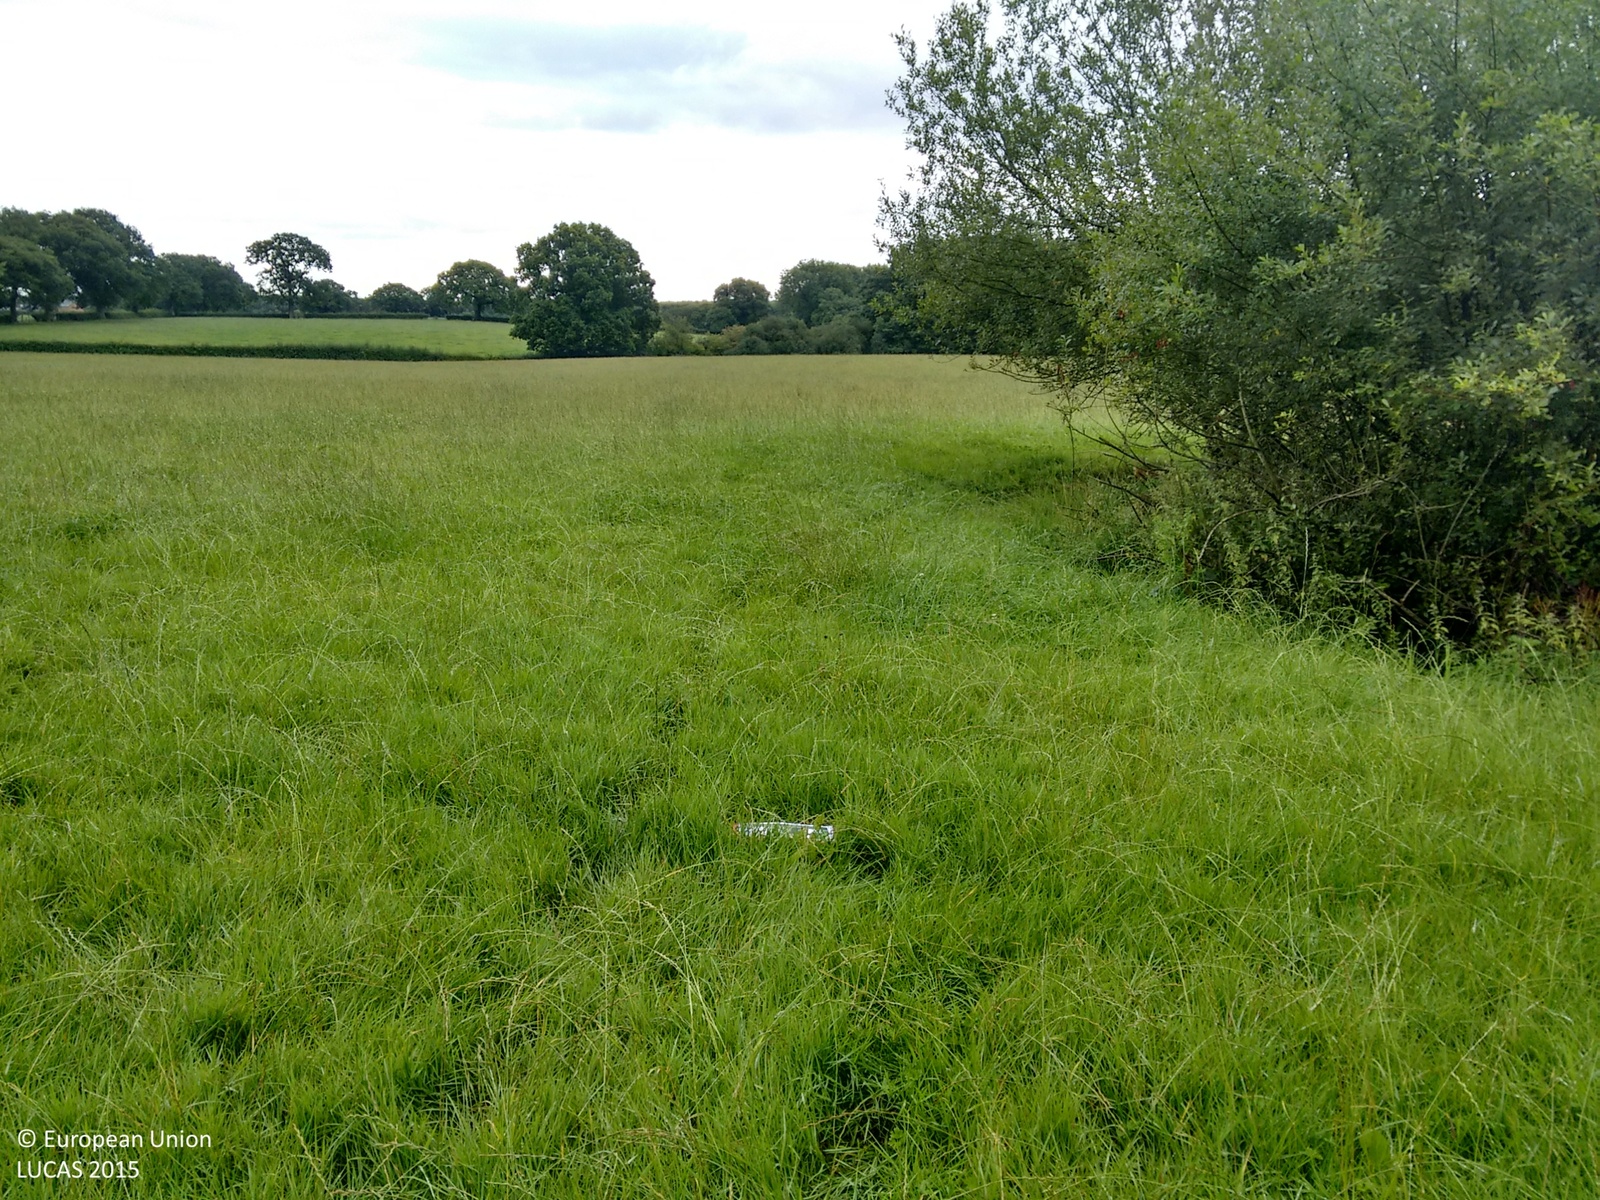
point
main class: Grassland
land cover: Grassland without tree/shrub cover
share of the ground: > 75 %
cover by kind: herbaceous plants 100 %
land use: Agriculture (excluding fallow land and kitchen gardens)
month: September
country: GB
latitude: 52.9434
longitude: -2.9156
